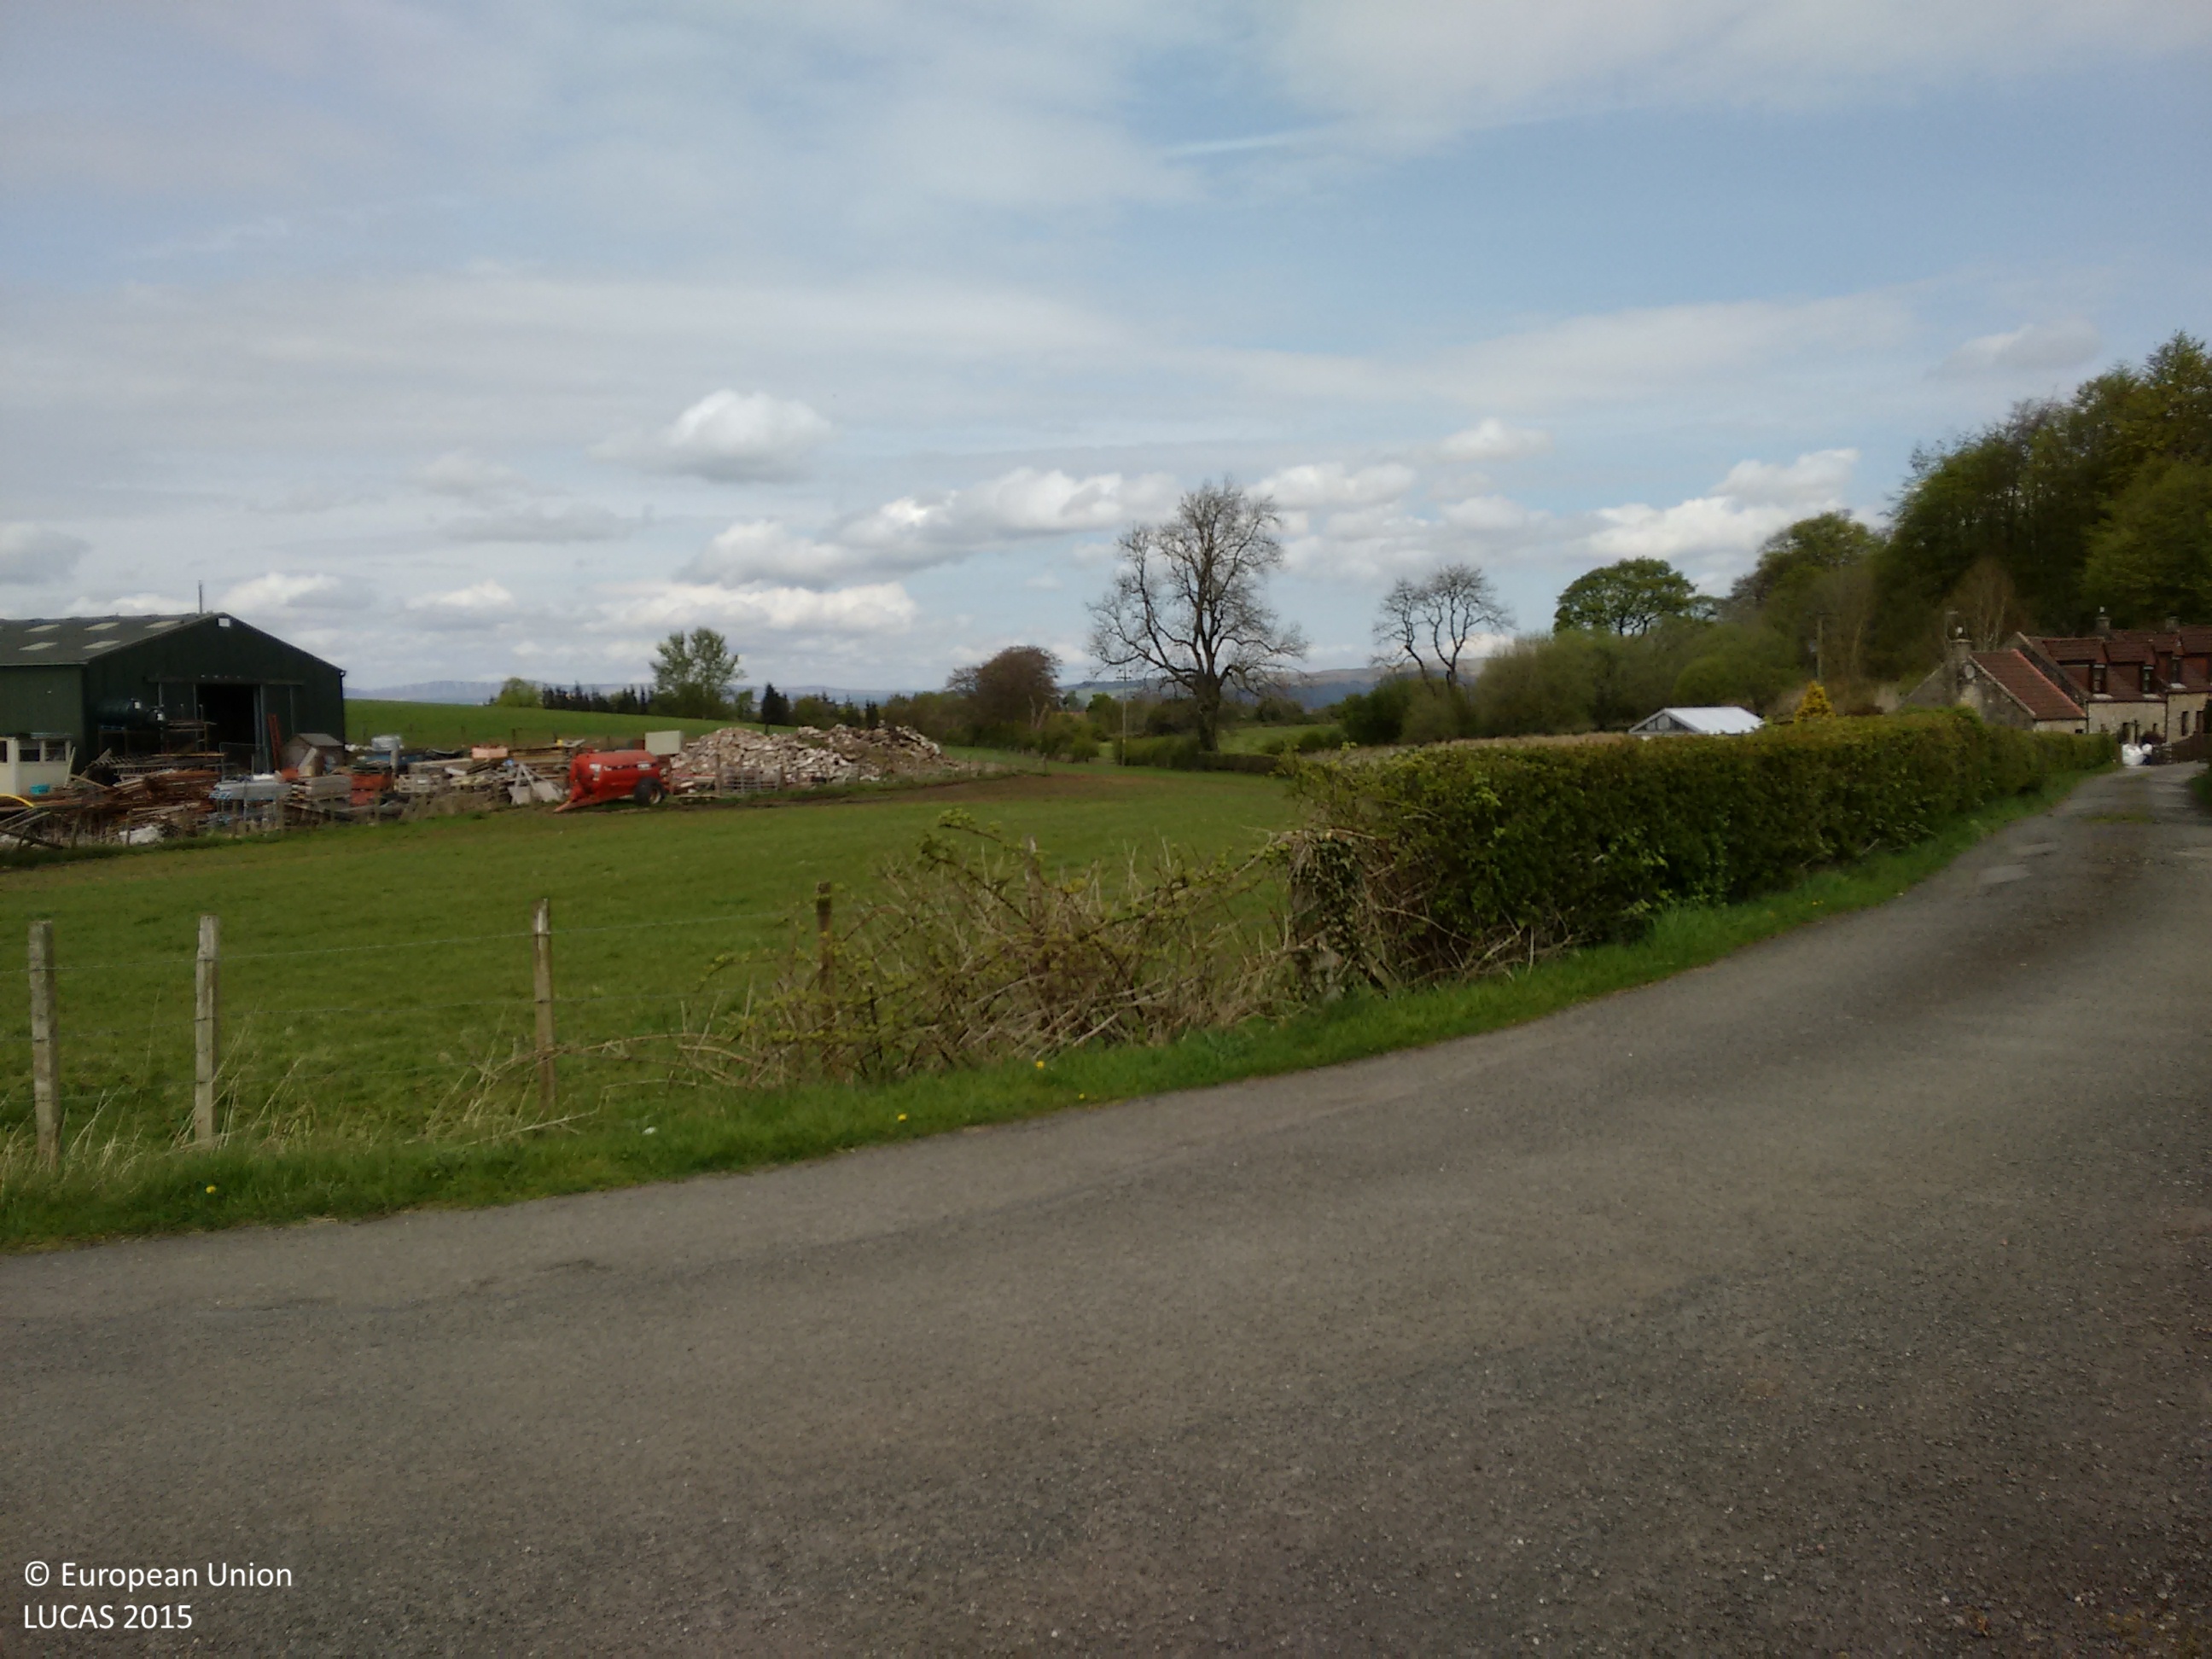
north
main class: Grassland
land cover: Grassland without tree/shrub cover
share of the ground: > 75 %
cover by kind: herbaceous plants 100 %
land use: Agriculture (excluding fallow land and kitchen gardens)
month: May
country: GB
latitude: 56.0819
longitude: -3.9205
